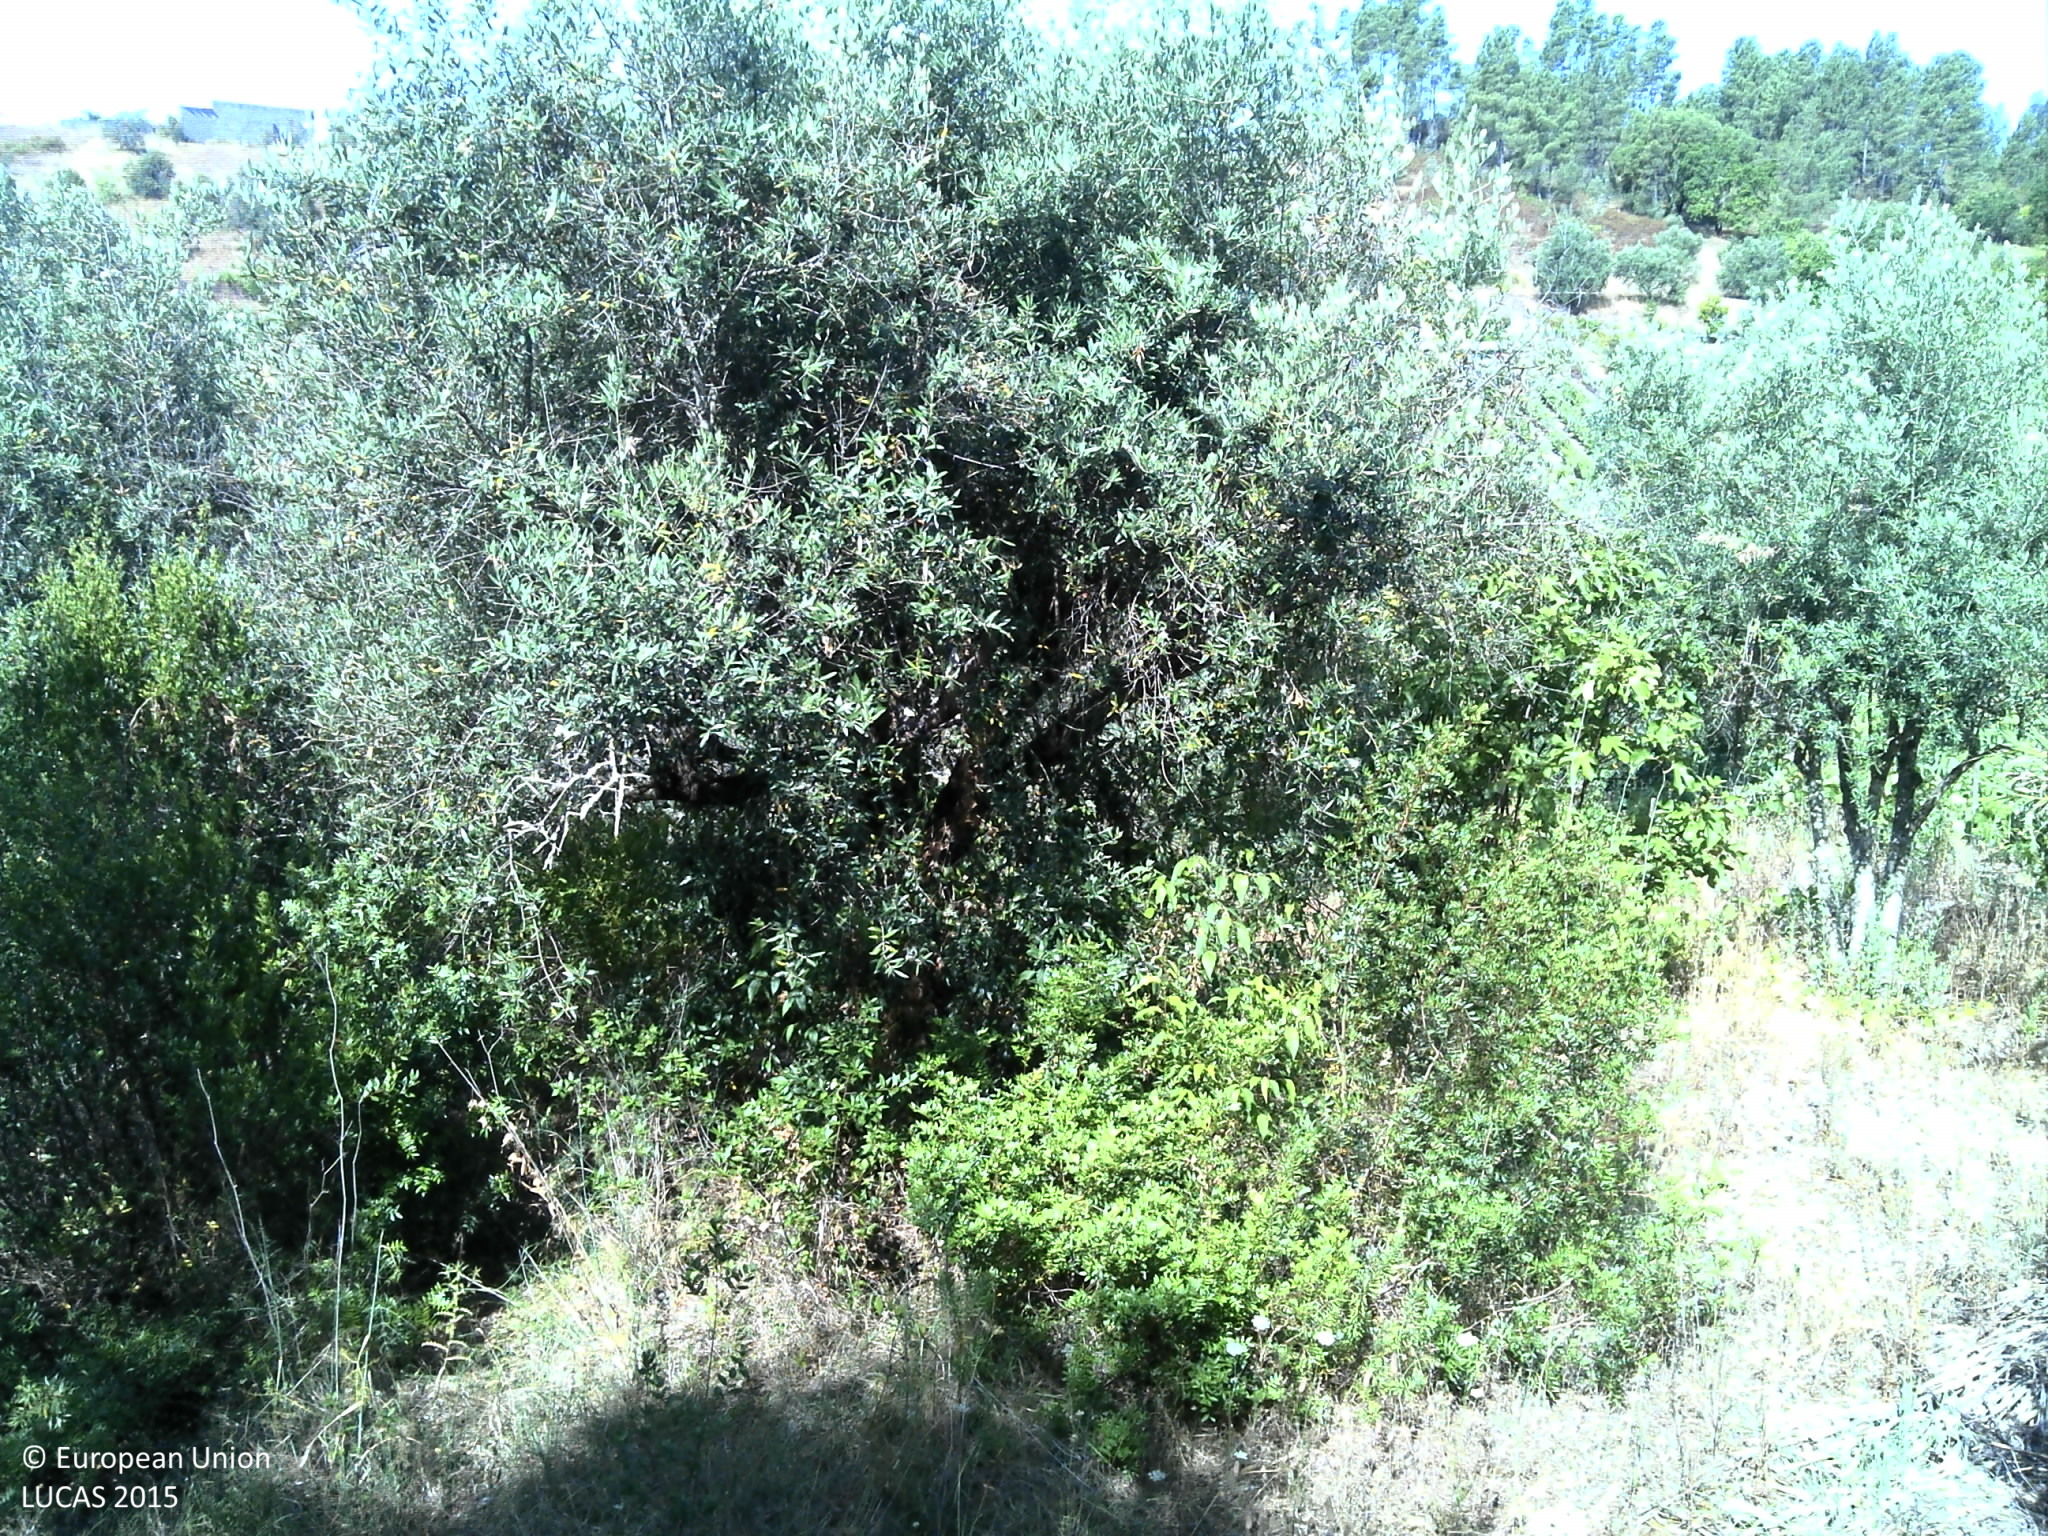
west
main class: Cropland
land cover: Olive groves
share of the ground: 10 - 25 %
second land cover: Shrubland without tree cover
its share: 25 - 50 %
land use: Agriculture (excluding fallow land and kitchen gardens)
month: July
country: PT
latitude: 39.4882
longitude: -8.0233
